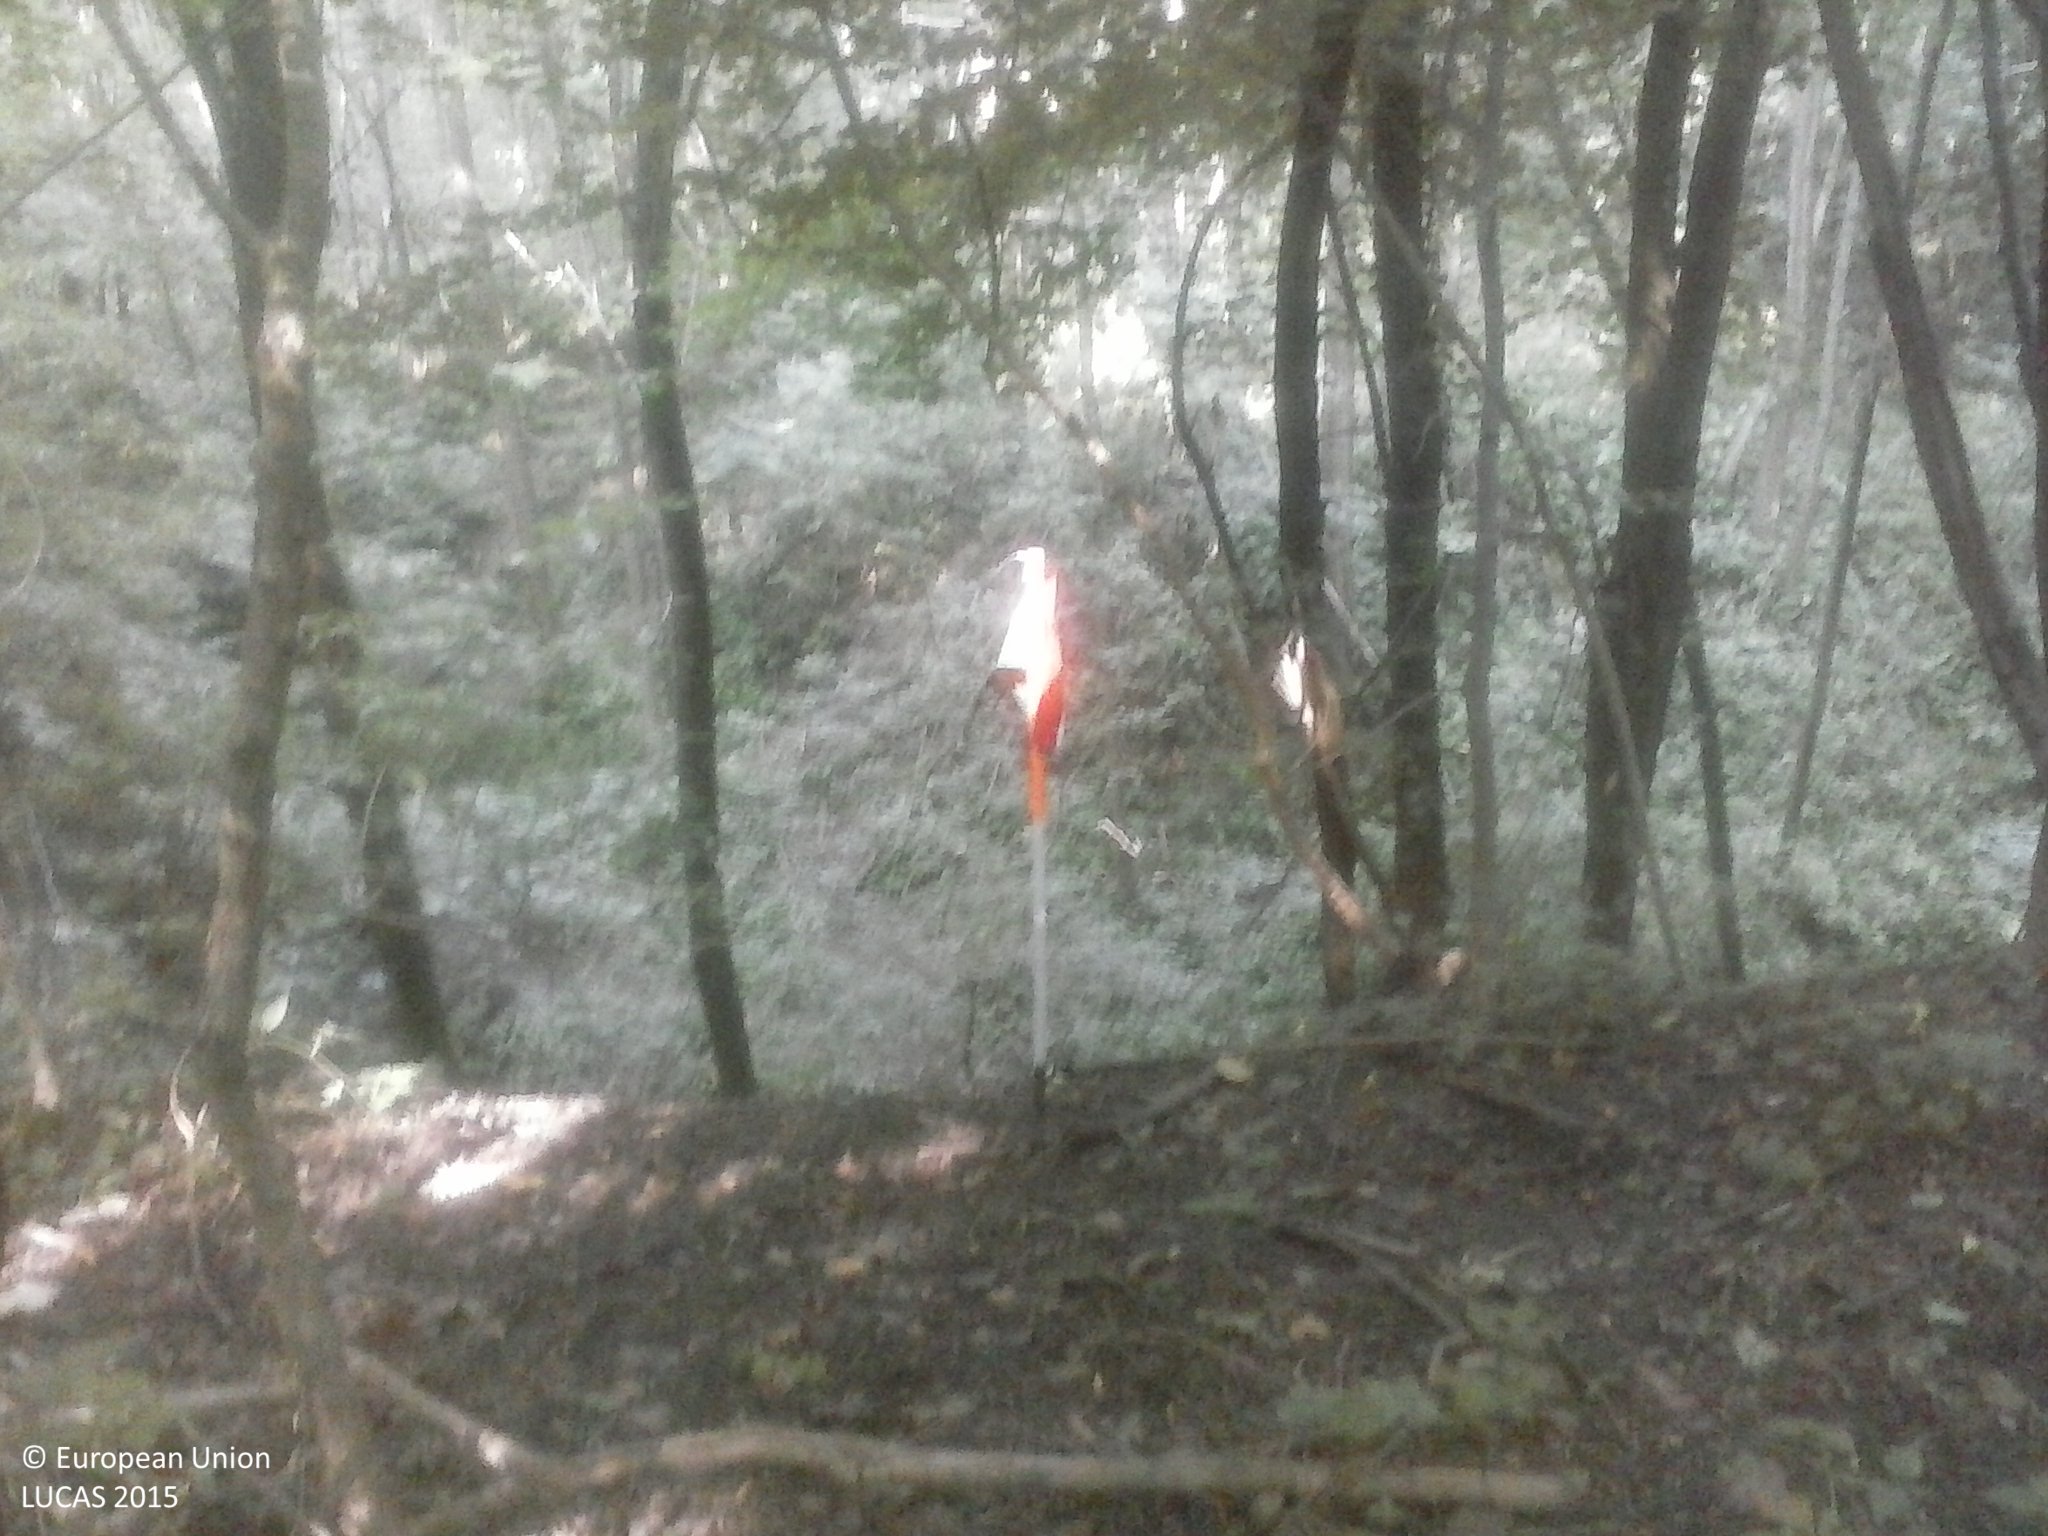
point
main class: Woodland
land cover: Broadleaved woodland
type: mesophytic deciduous forest
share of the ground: > 75 %
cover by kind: broadleaved forest trees 90 %, shrubs 5 %, herbaceous plants 5 %
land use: Semi-natural and natural areas not in use
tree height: > 5 m
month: August
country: HU
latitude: 46.2093
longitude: 17.8212
